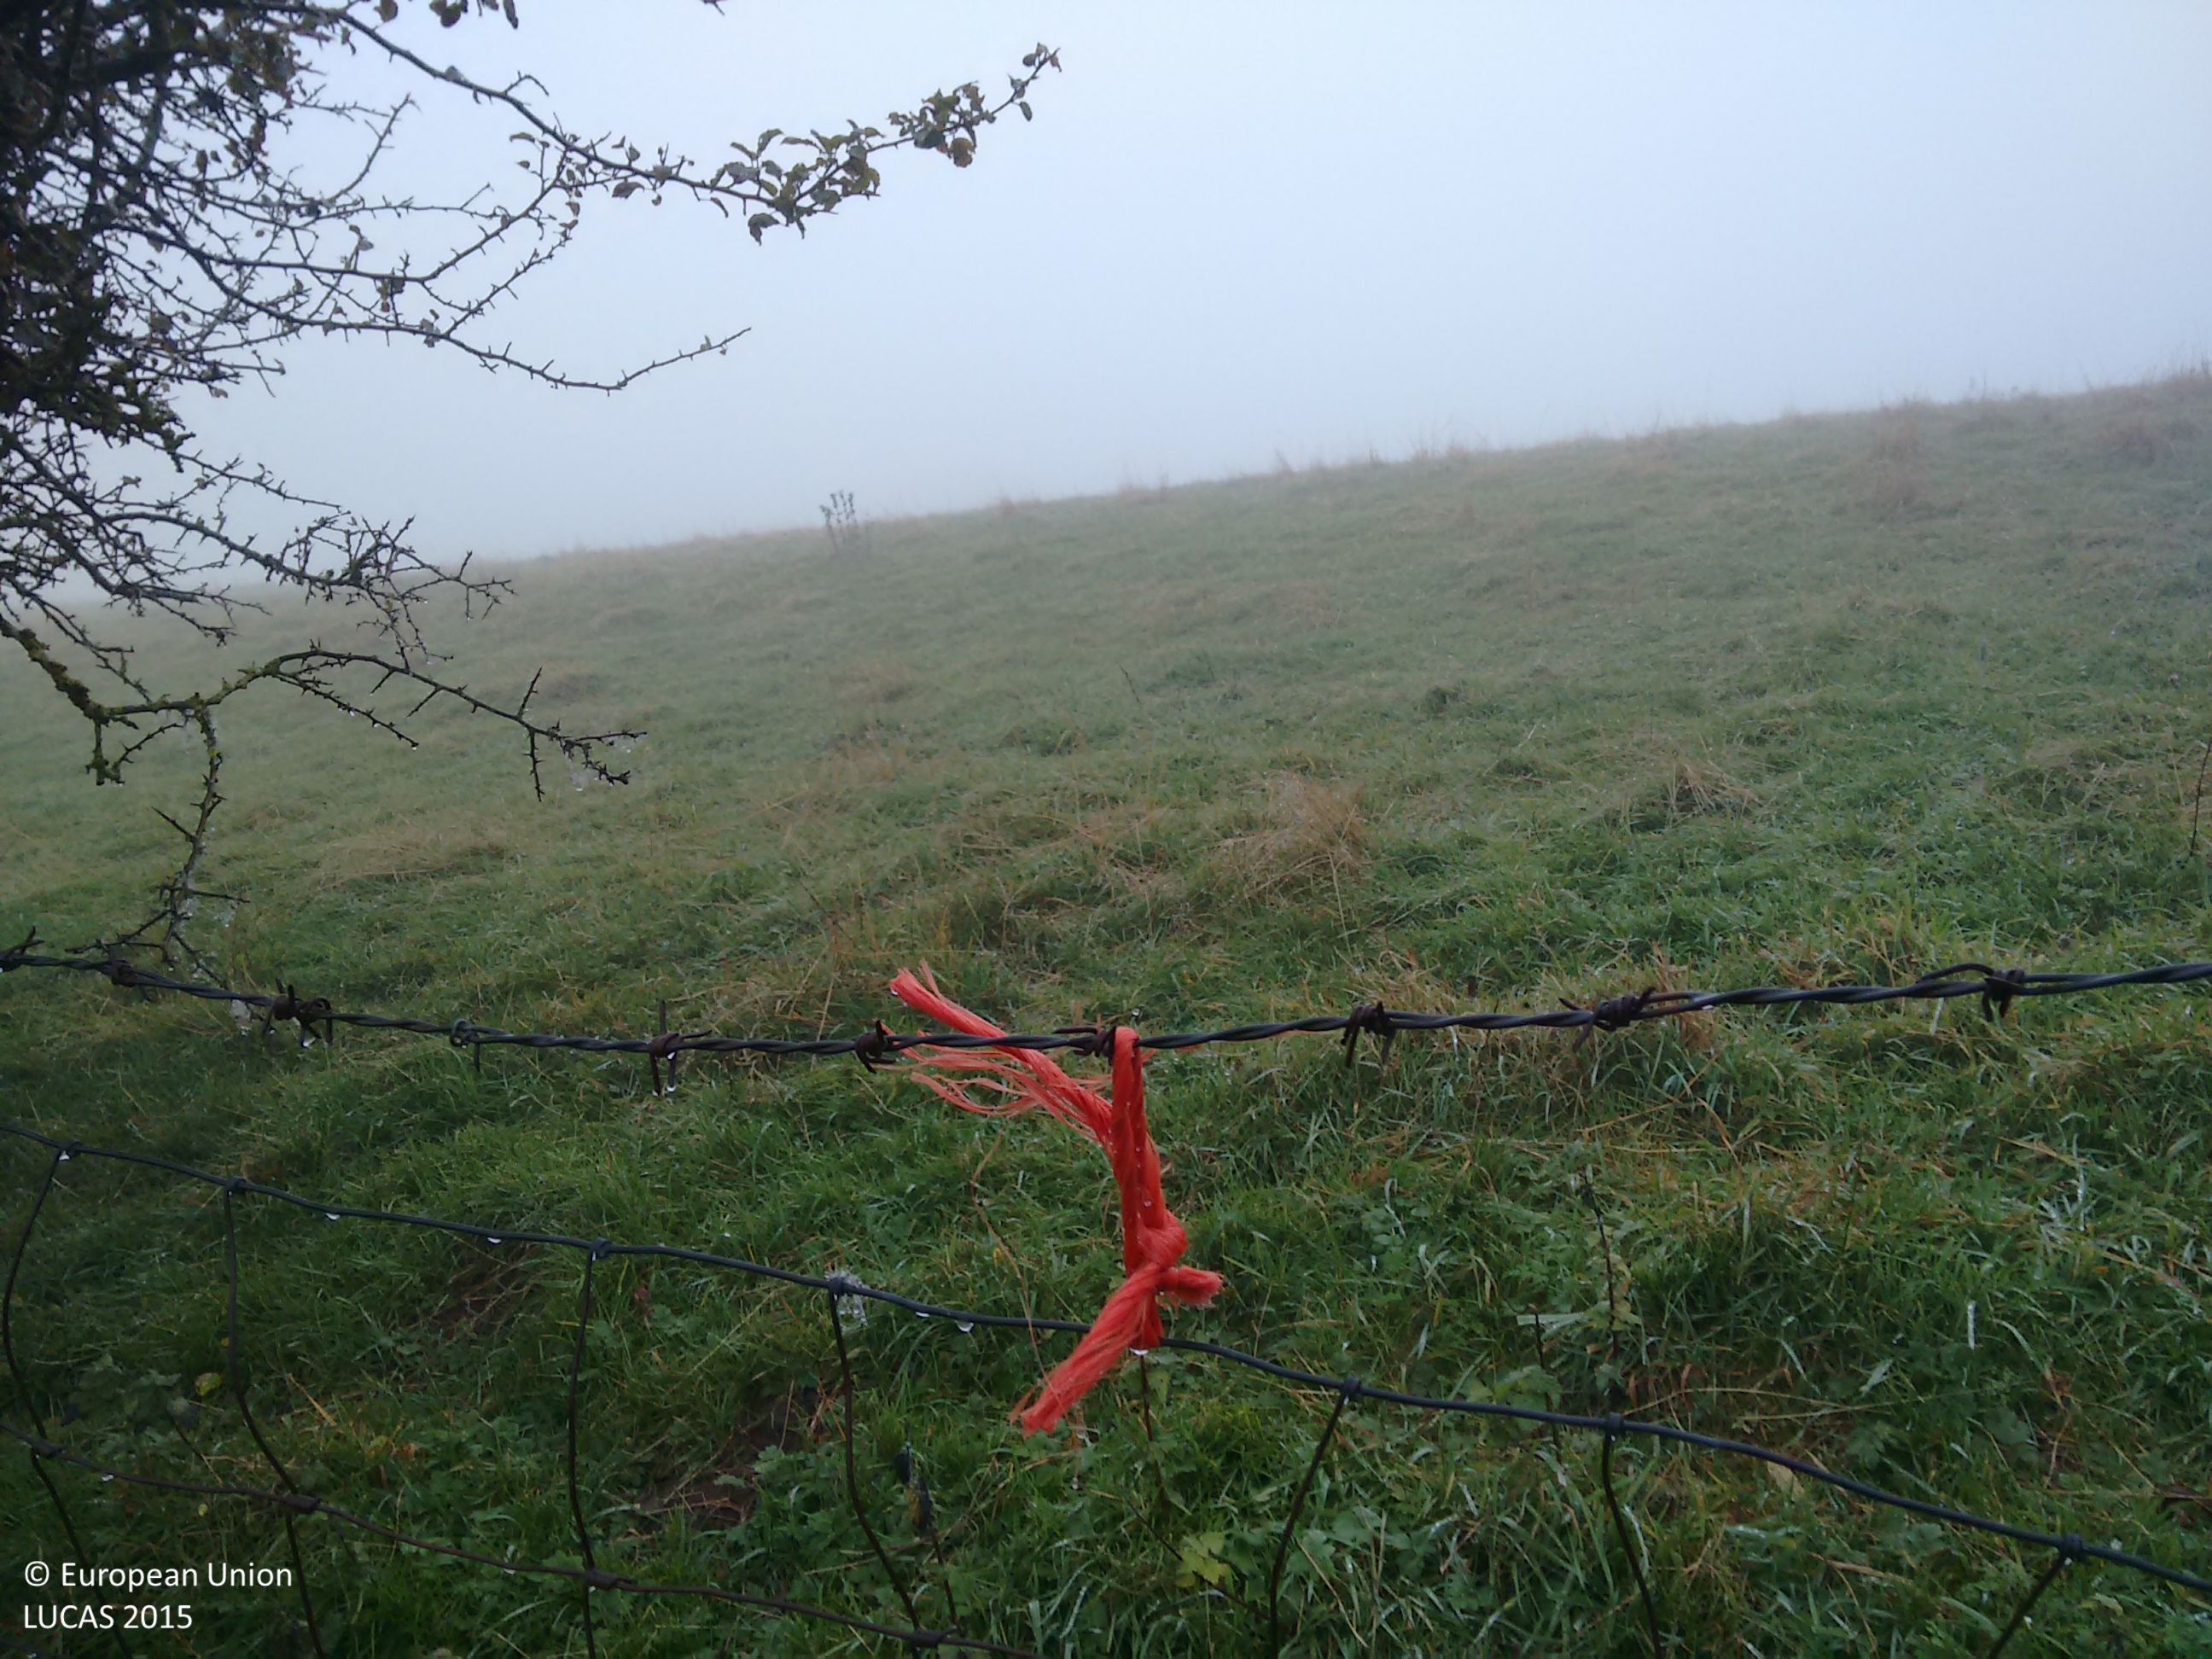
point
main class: Grassland
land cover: Grassland without tree/shrub cover
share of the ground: > 75 %
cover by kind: herbaceous plants 100 %
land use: Agriculture (excluding fallow land and kitchen gardens)
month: October
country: GB
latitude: 54.4803
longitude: -1.9547
